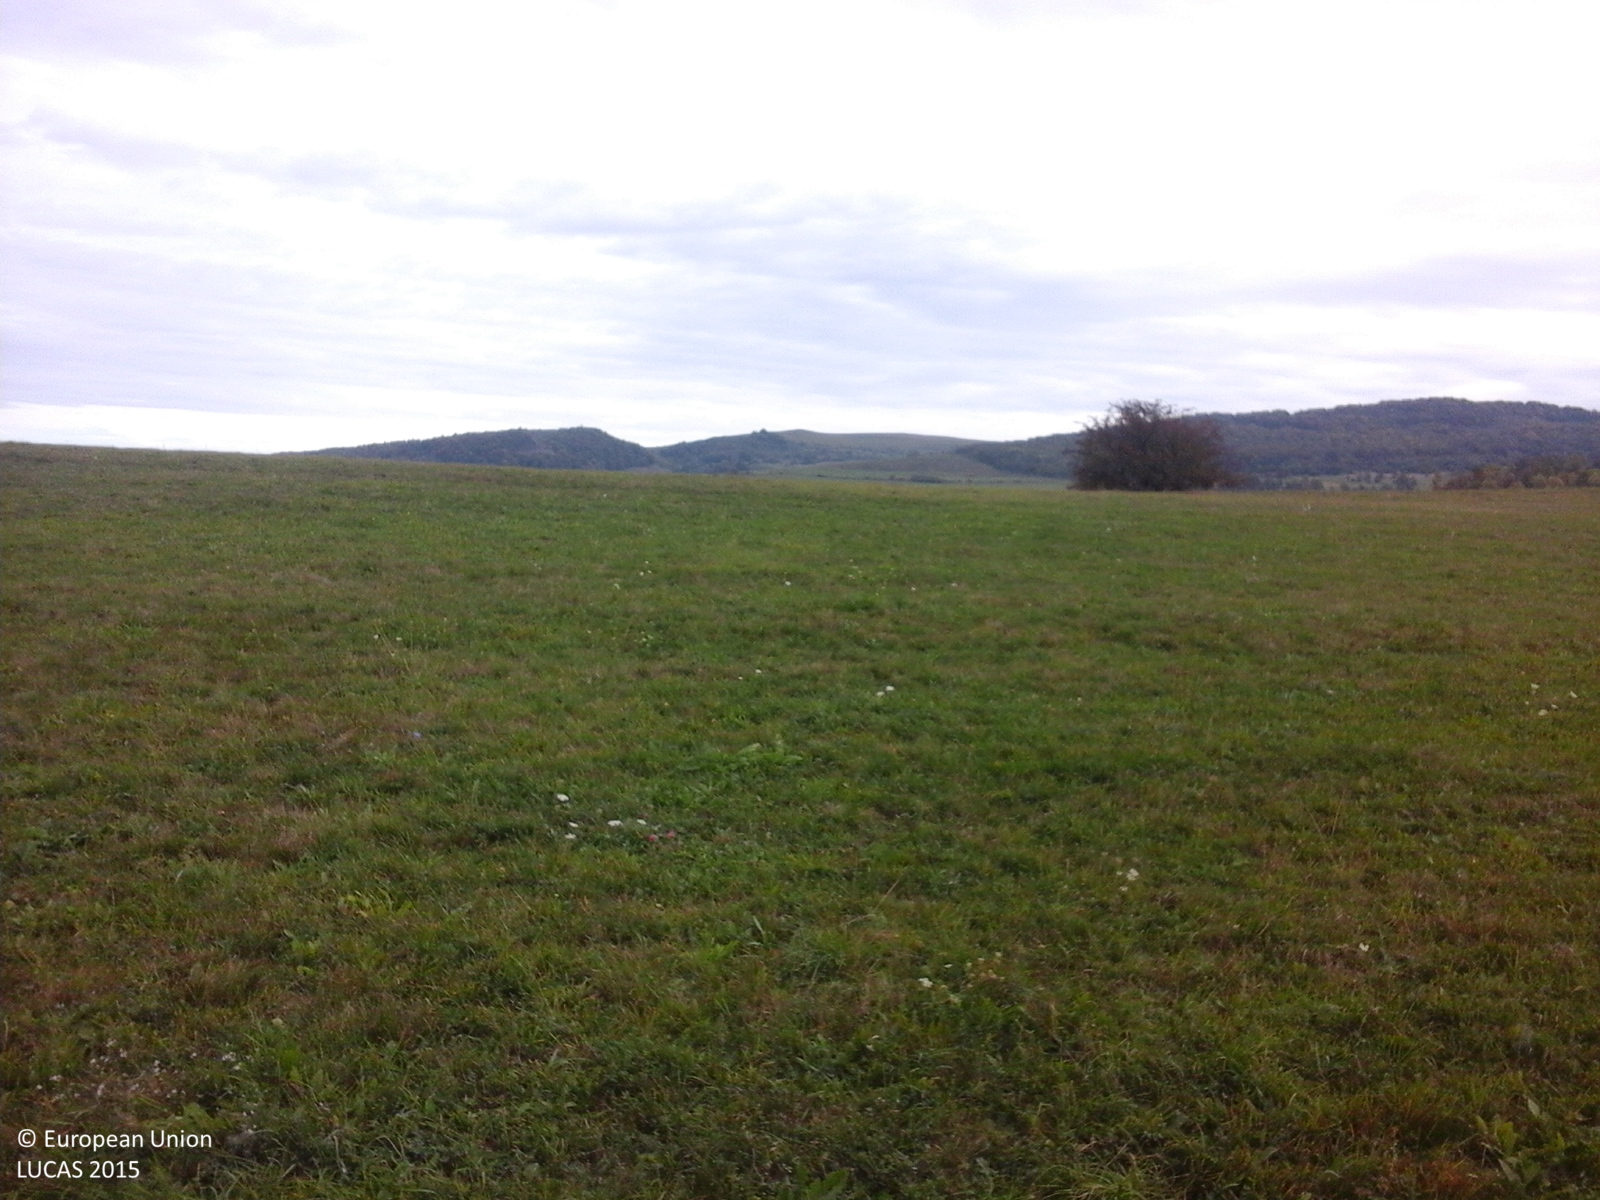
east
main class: Grassland
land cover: Grassland without tree/shrub cover
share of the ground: > 75 %
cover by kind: herbaceous plants 100 %
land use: Agriculture (excluding fallow land and kitchen gardens)
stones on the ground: < 10 %
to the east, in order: Grassland without tree/shrub cover; Tracks; Grassland without tree/shrub cover; Ditches and canals; Tracks; Fences; Abandoned hedges; Other fruit trees and berries
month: October
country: RO
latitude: 46.2335
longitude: 25.2863
